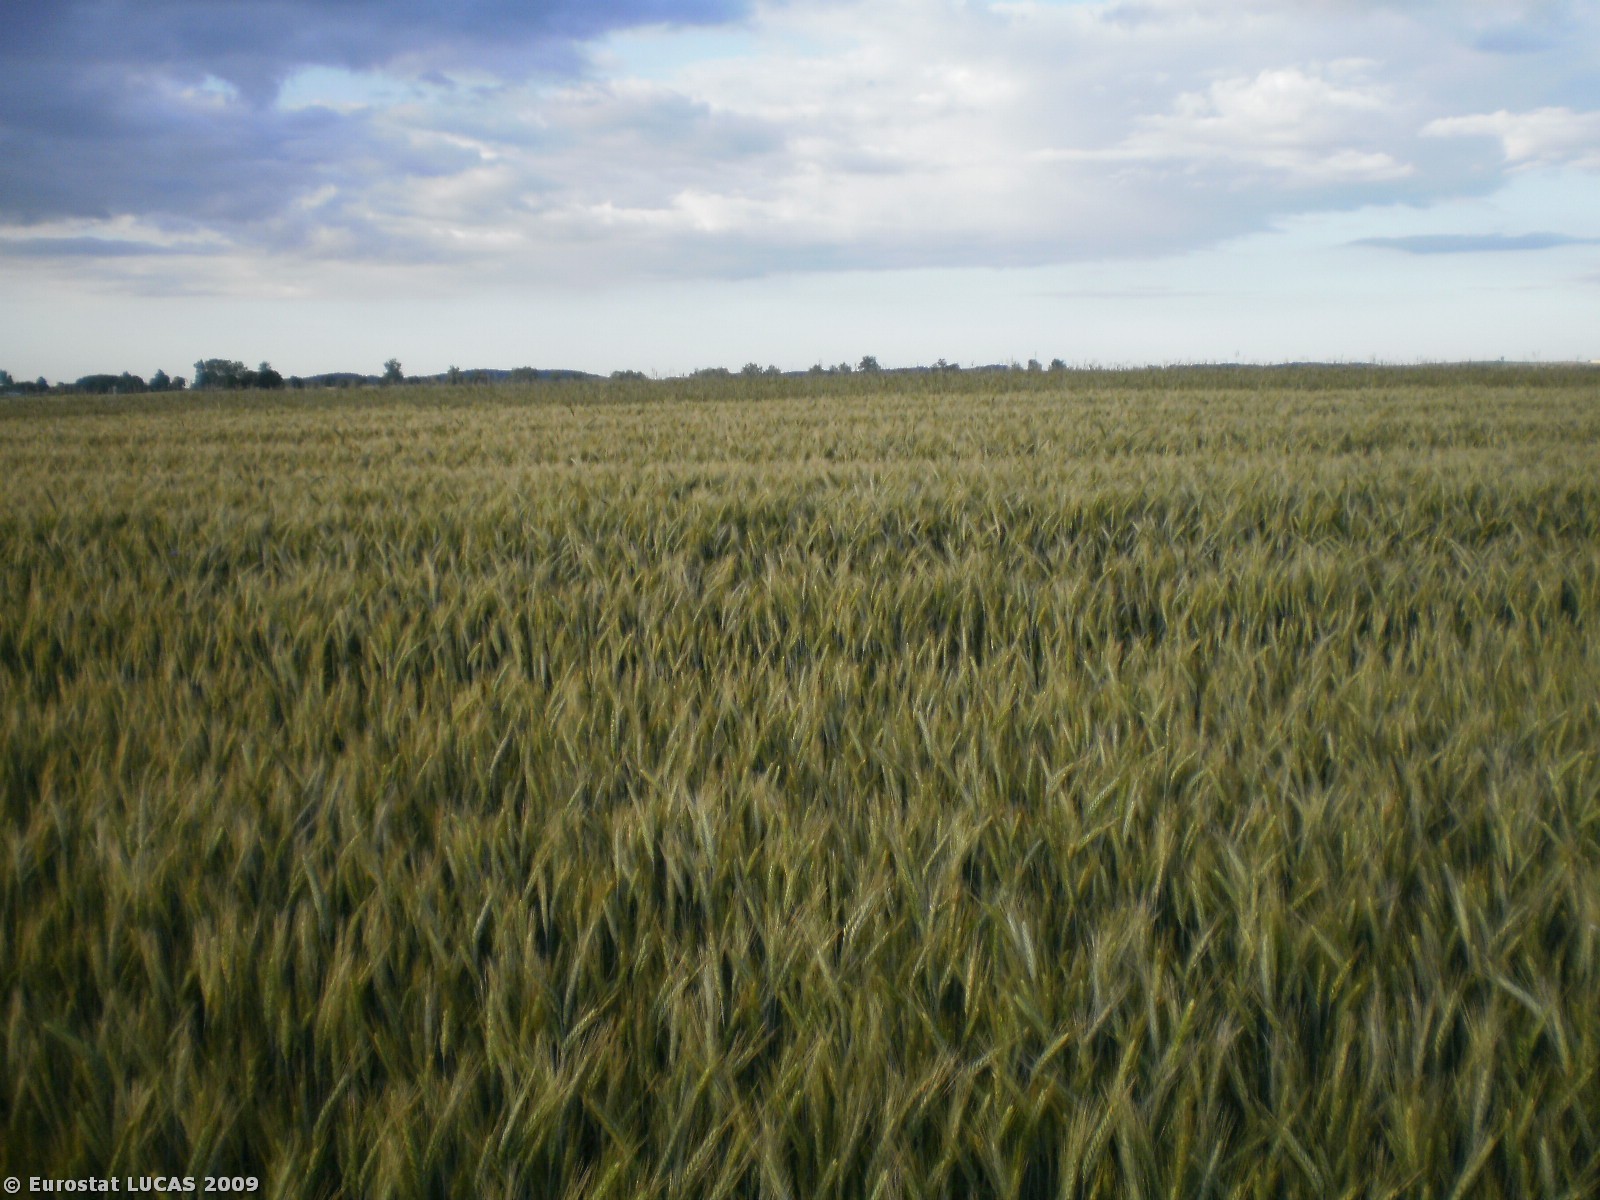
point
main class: Cropland
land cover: Triticale
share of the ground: > 75 %
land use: Agriculture (excluding fallow land and kitchen gardens)
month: June
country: PL
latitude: 53.4917
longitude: 19.8118
